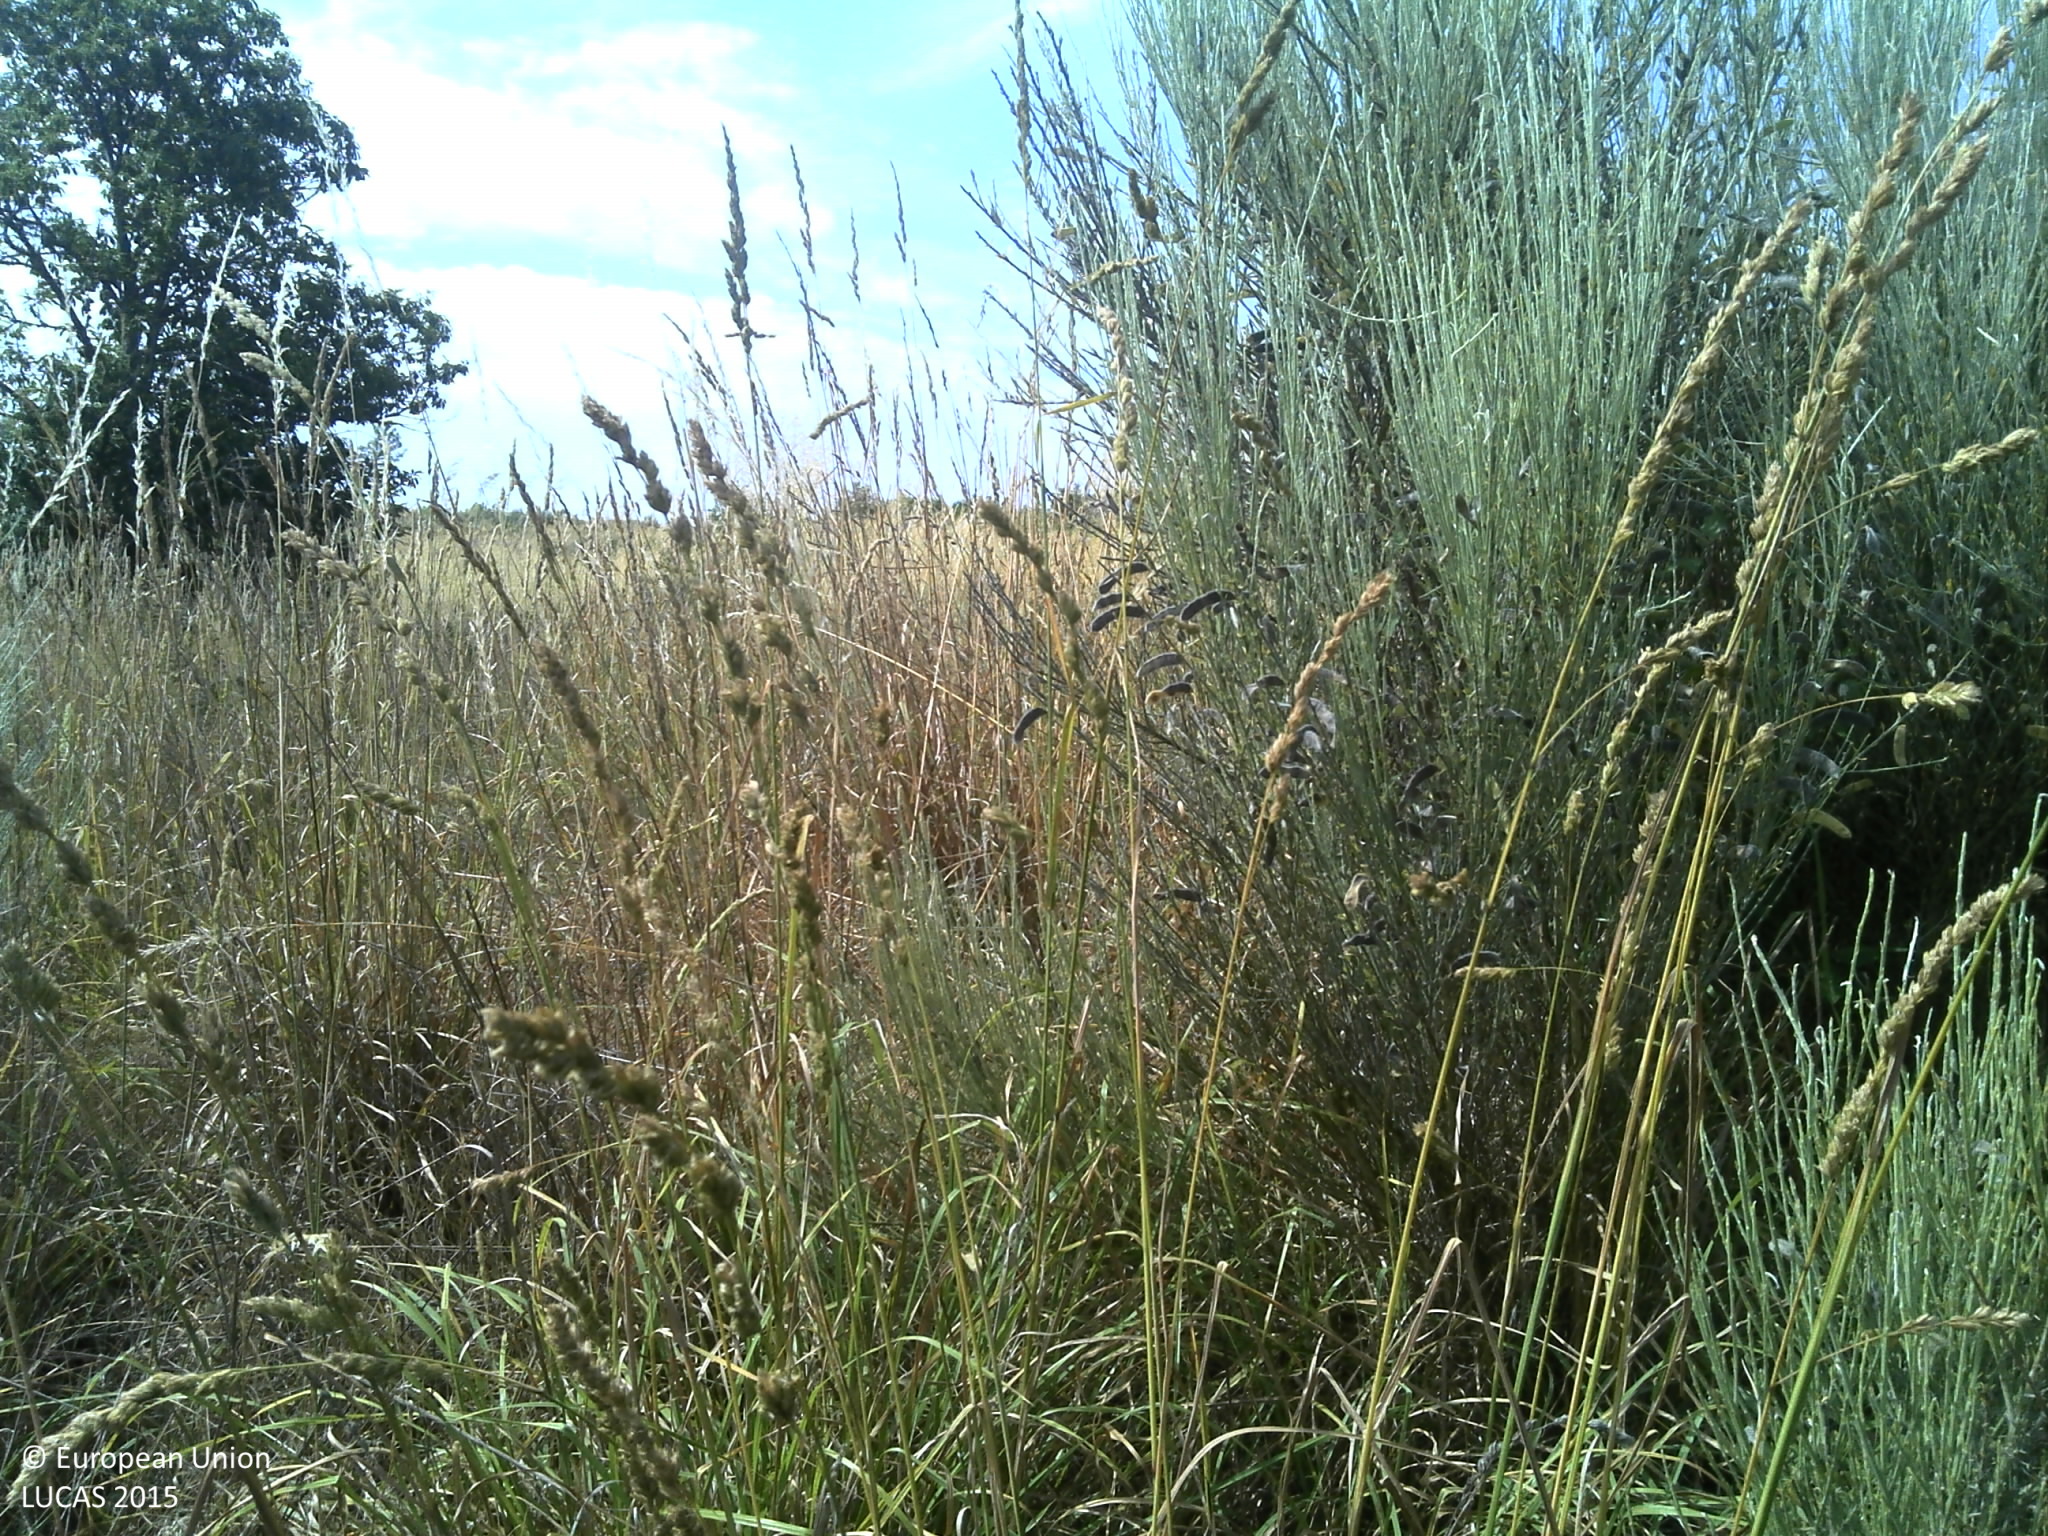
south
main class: Shrubland
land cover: Shrubland without tree cover
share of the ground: 50 - 75 %
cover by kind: shrubs 50 %, unconsolidated bare surface 25 %, herbaceous plants 20 %, consolidated bare surface 5 %
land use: Semi-natural and natural areas not in use
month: July
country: PT
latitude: 40.9322
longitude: -7.3956
